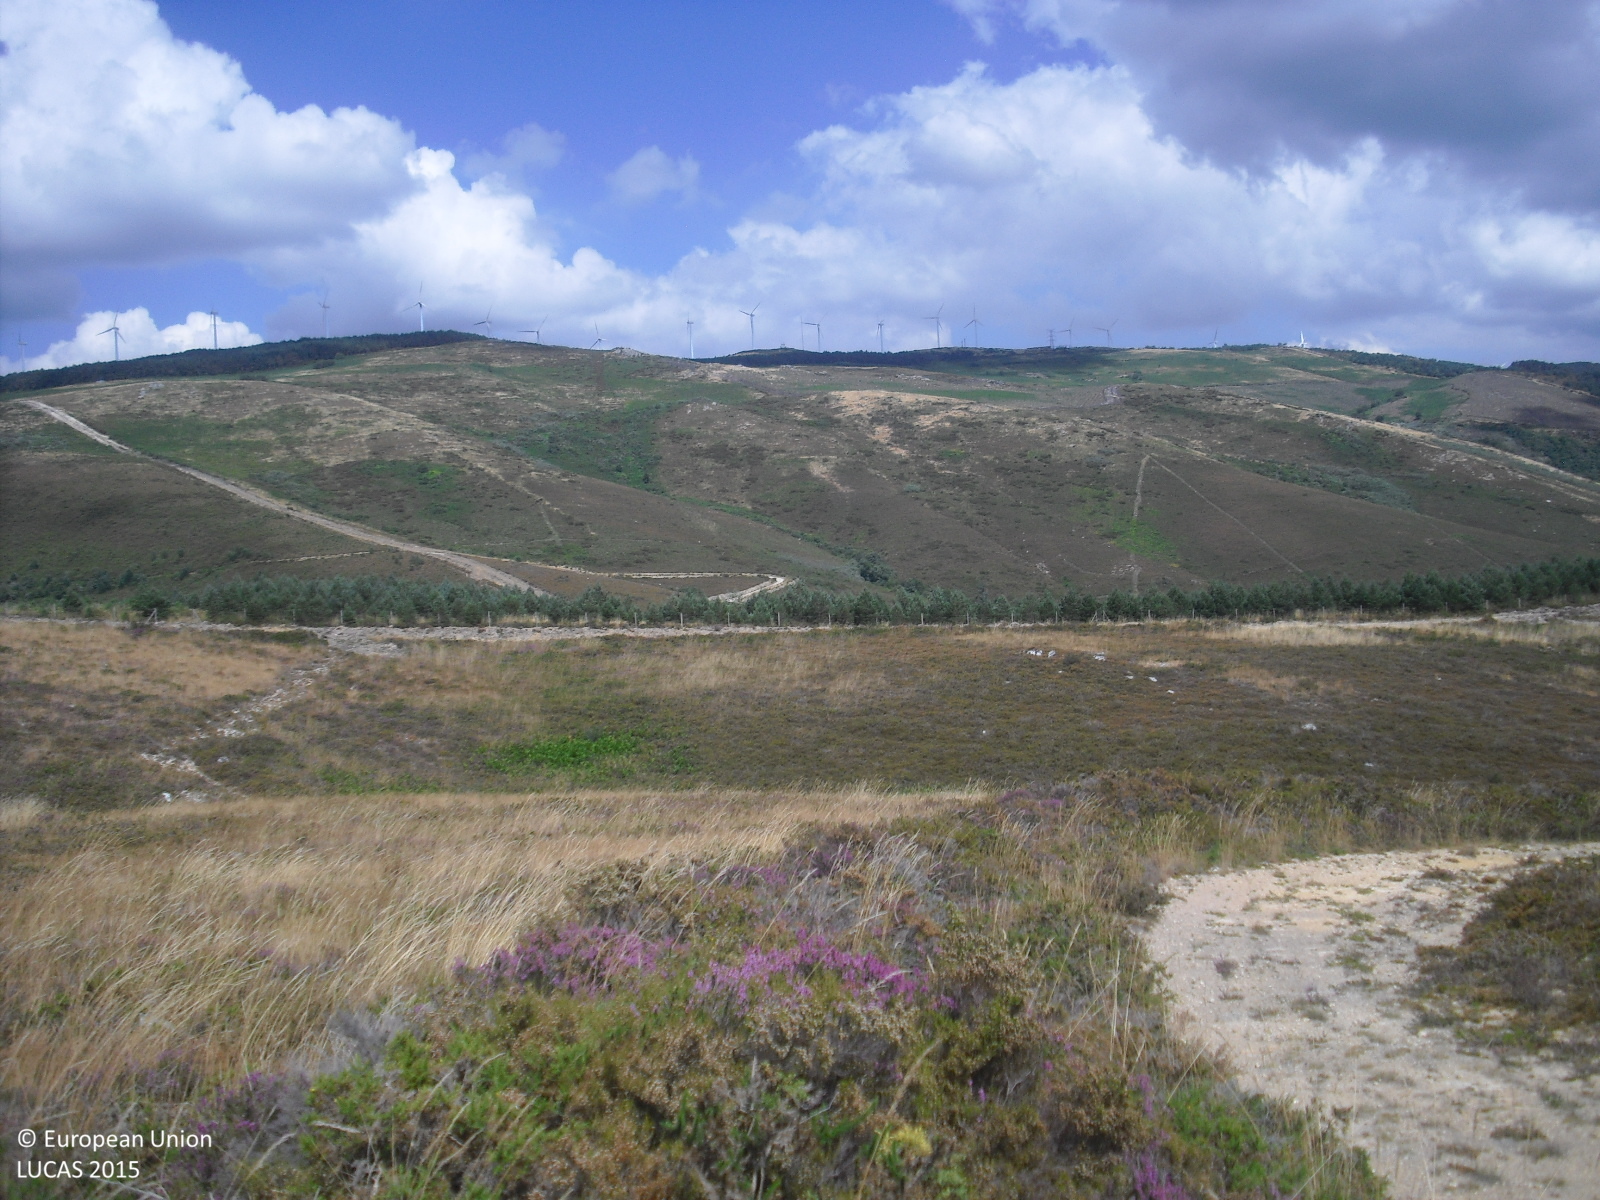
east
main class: Shrubland
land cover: Shrubland without tree cover
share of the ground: > 75 %
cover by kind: shrubs 80 %, unconsolidated bare surface 20 %
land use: Sport
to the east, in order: Shrubland without tree cover; Tracks; Shrubland without tree cover; Rivers and streams; Shrubland without tree cover; Rock outcrops; Shrubland without tree cover; Other structural elements; Fences; Pine dominated coniferous woodland
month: July
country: ES
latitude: 42.3594
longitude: -7.6646
